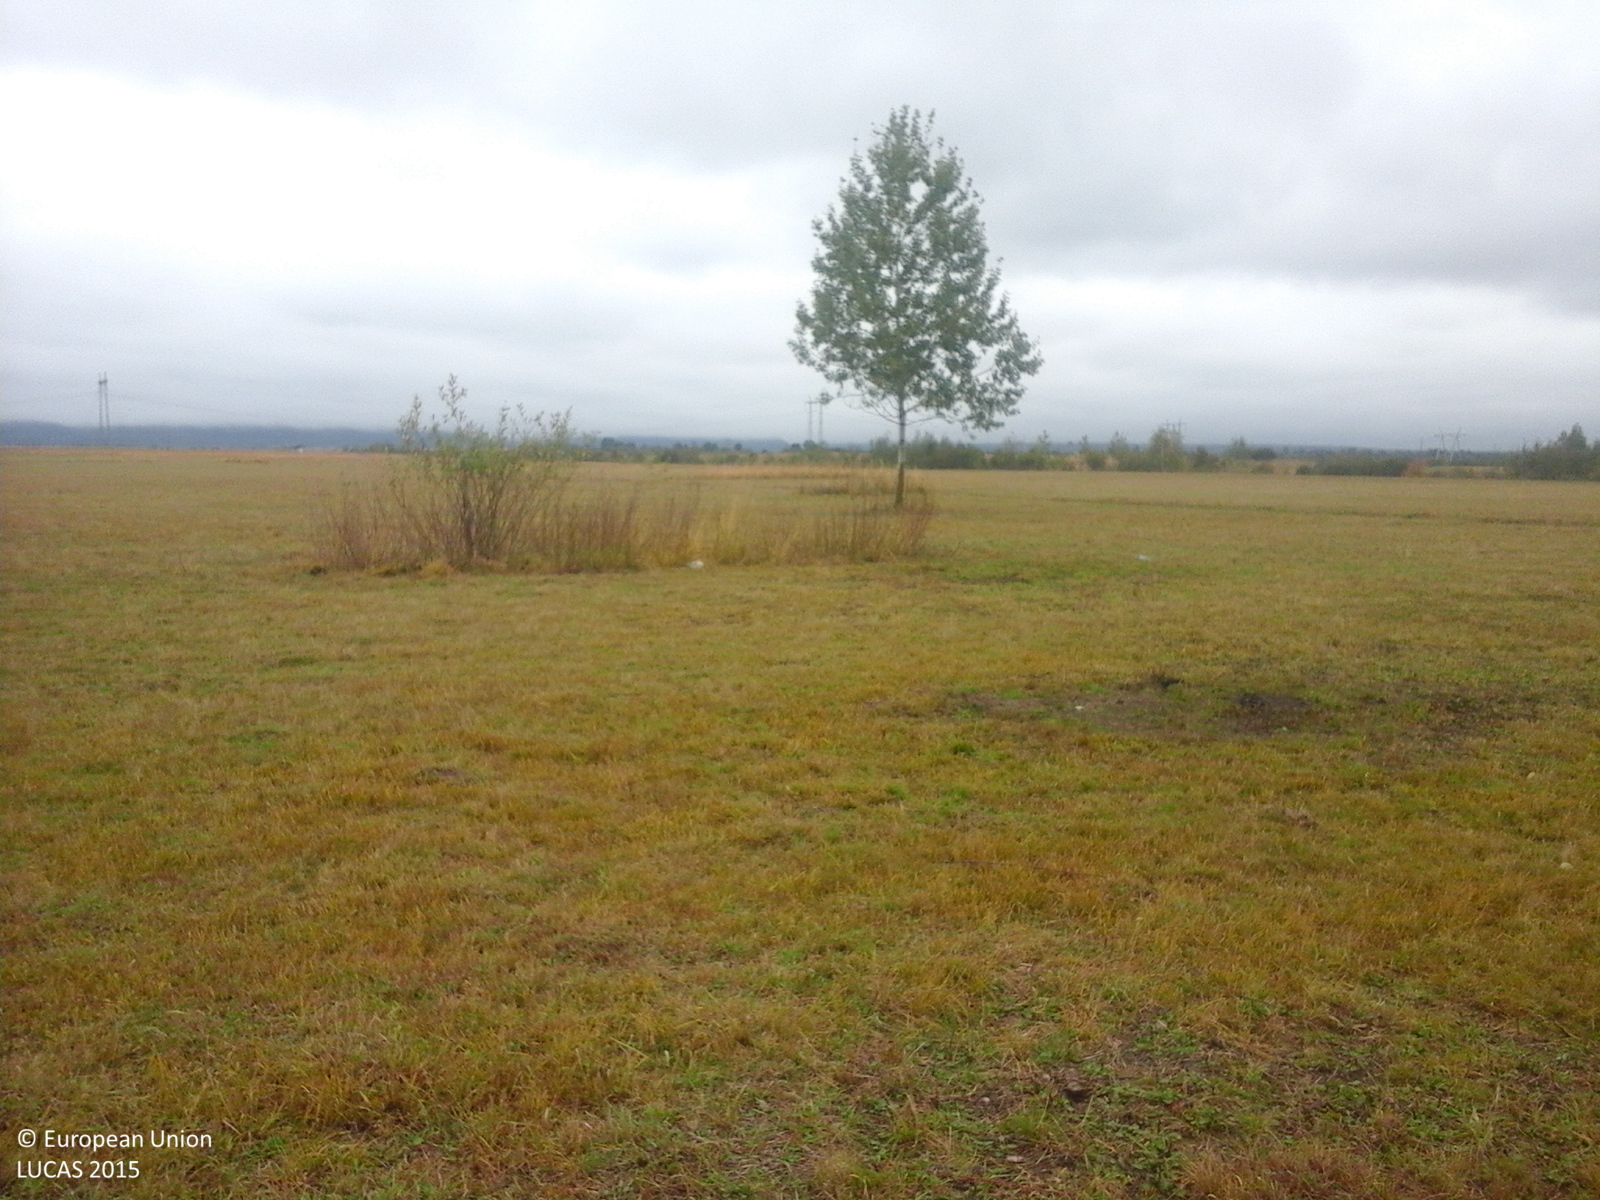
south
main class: Grassland
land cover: Grassland without tree/shrub cover
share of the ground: > 75 %
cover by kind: herbaceous plants 100 %
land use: Agriculture (excluding fallow land and kitchen gardens)
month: October
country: RO
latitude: 45.7459
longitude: 24.5951
